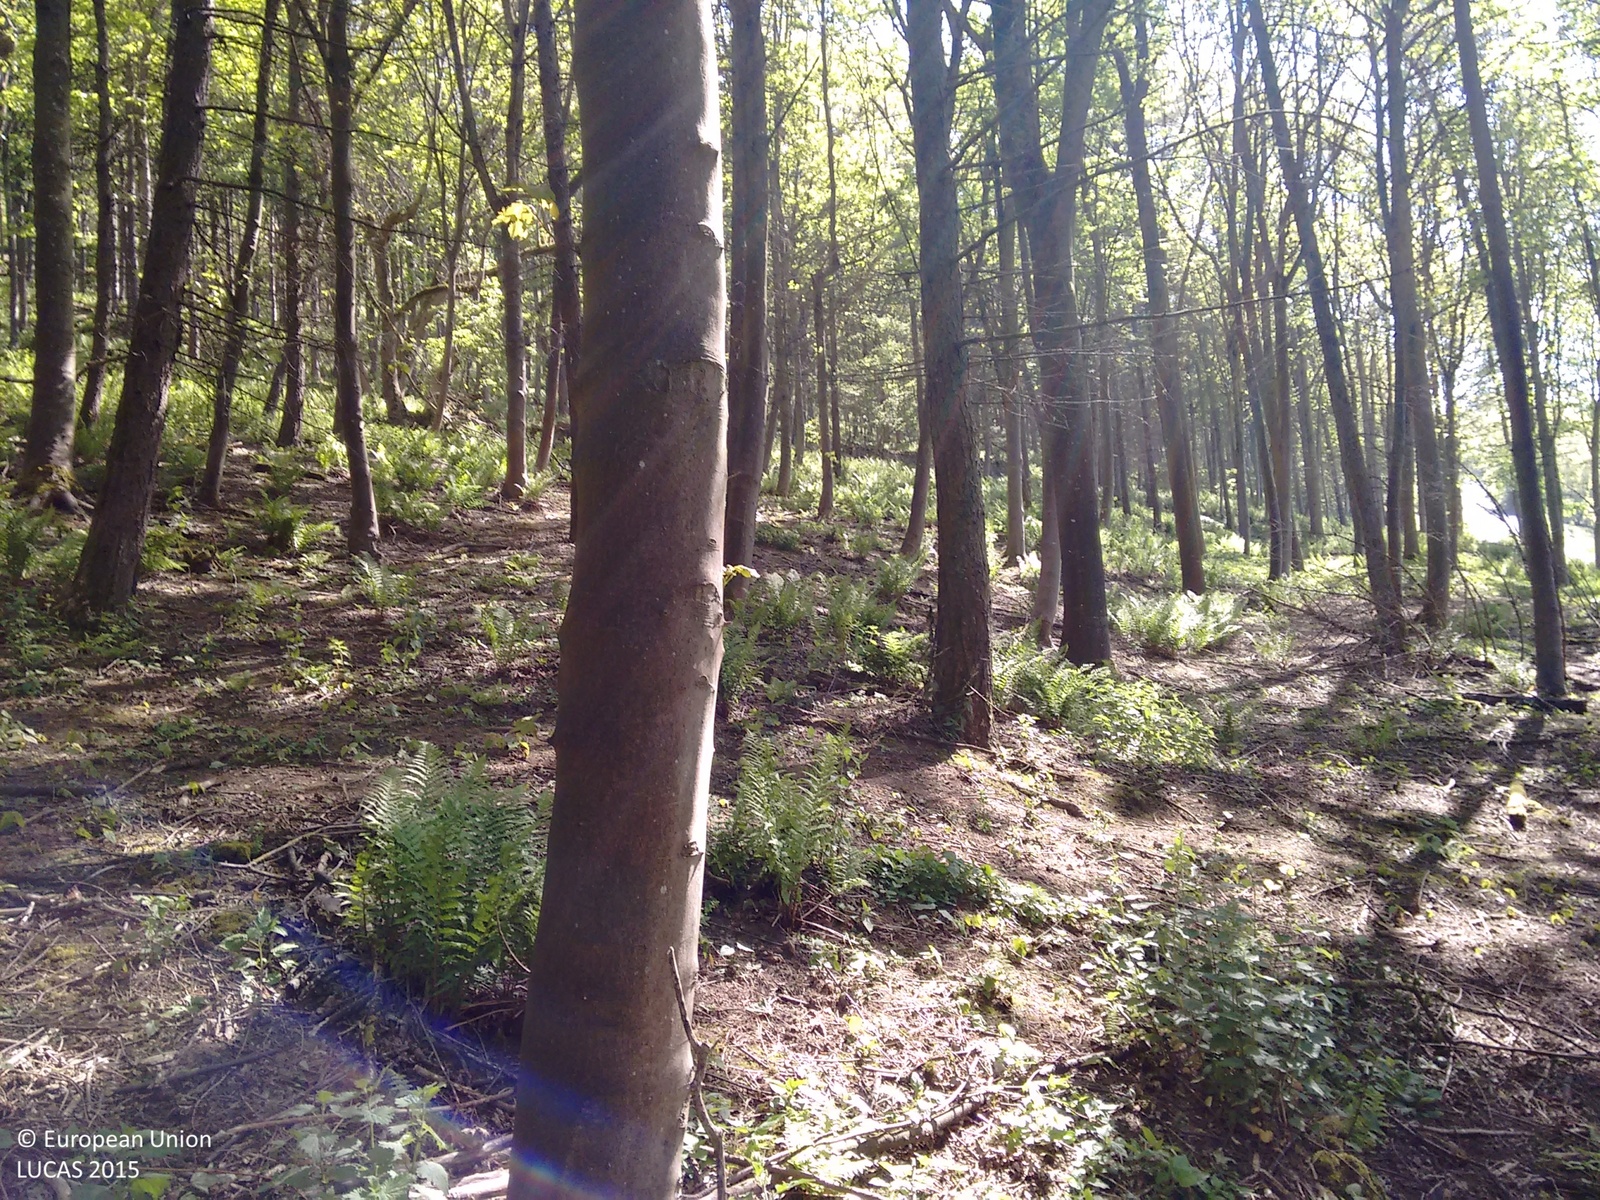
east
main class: Woodland
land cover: Broadleaved woodland
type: mesophytic deciduous forest
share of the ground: > 75 %
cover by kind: broadleaved forest trees 75 %, coniferous forest trees 25 %
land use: Forestry
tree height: > 5 m
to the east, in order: Broadleaved woodland
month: June
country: GB
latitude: 54.3211
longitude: -1.9083
